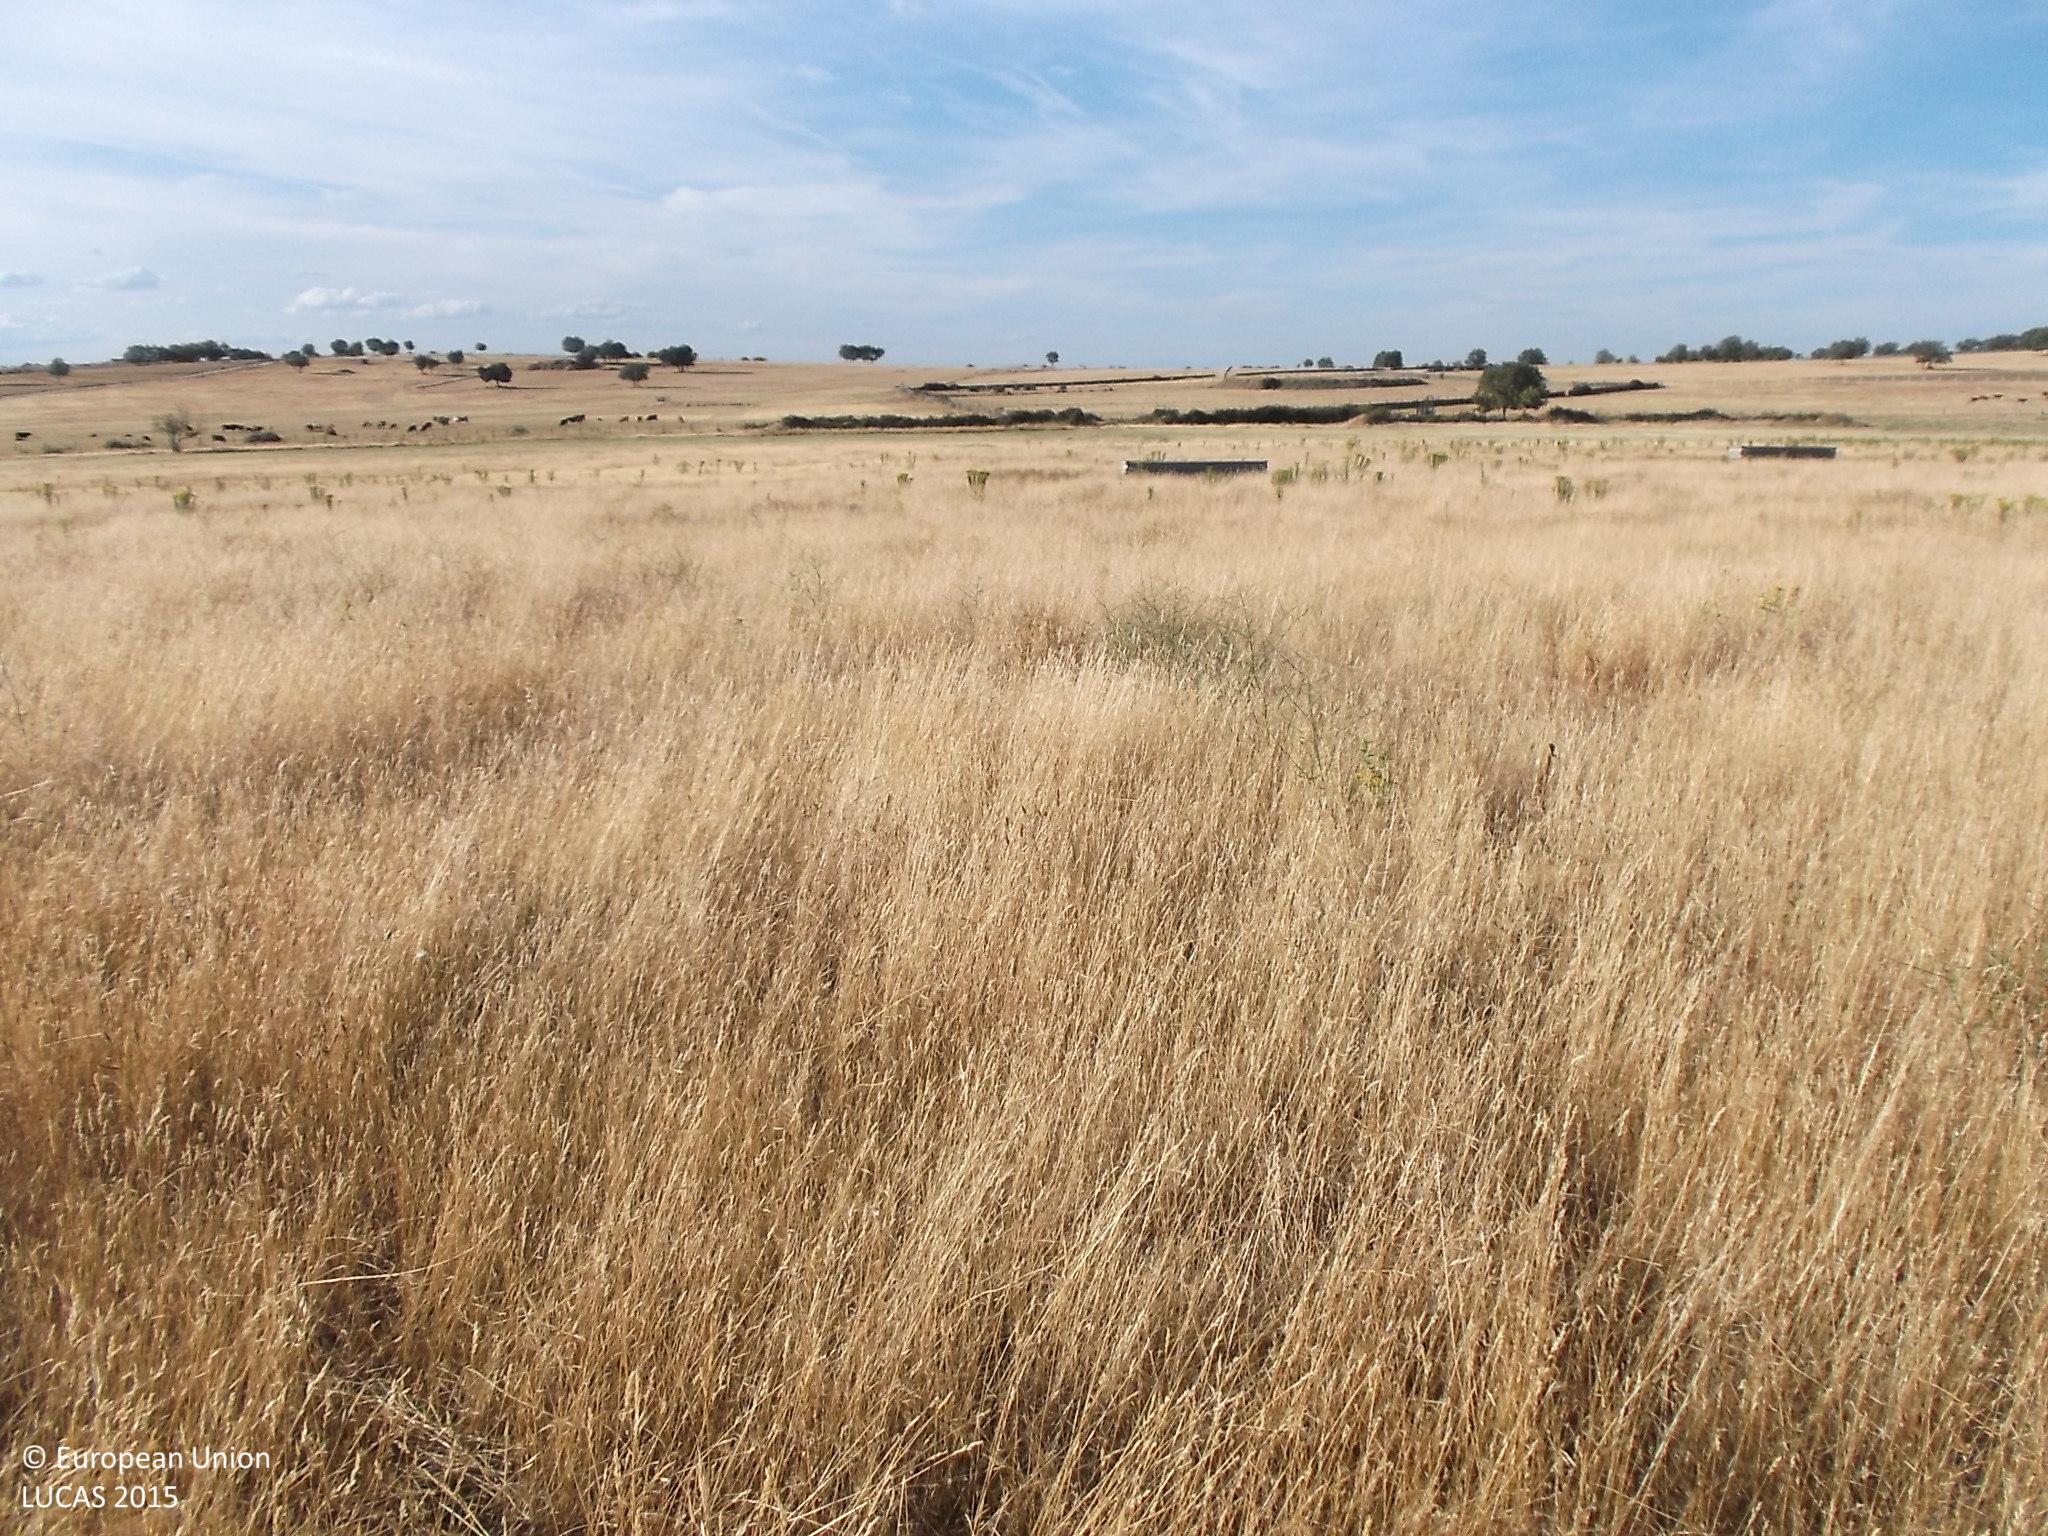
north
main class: Grassland
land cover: Grassland without tree/shrub cover
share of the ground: > 75 %
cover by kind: herbaceous plants 100 %
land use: Agriculture (excluding fallow land and kitchen gardens)
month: July
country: ES
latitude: 41.0189
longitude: -6.4700
